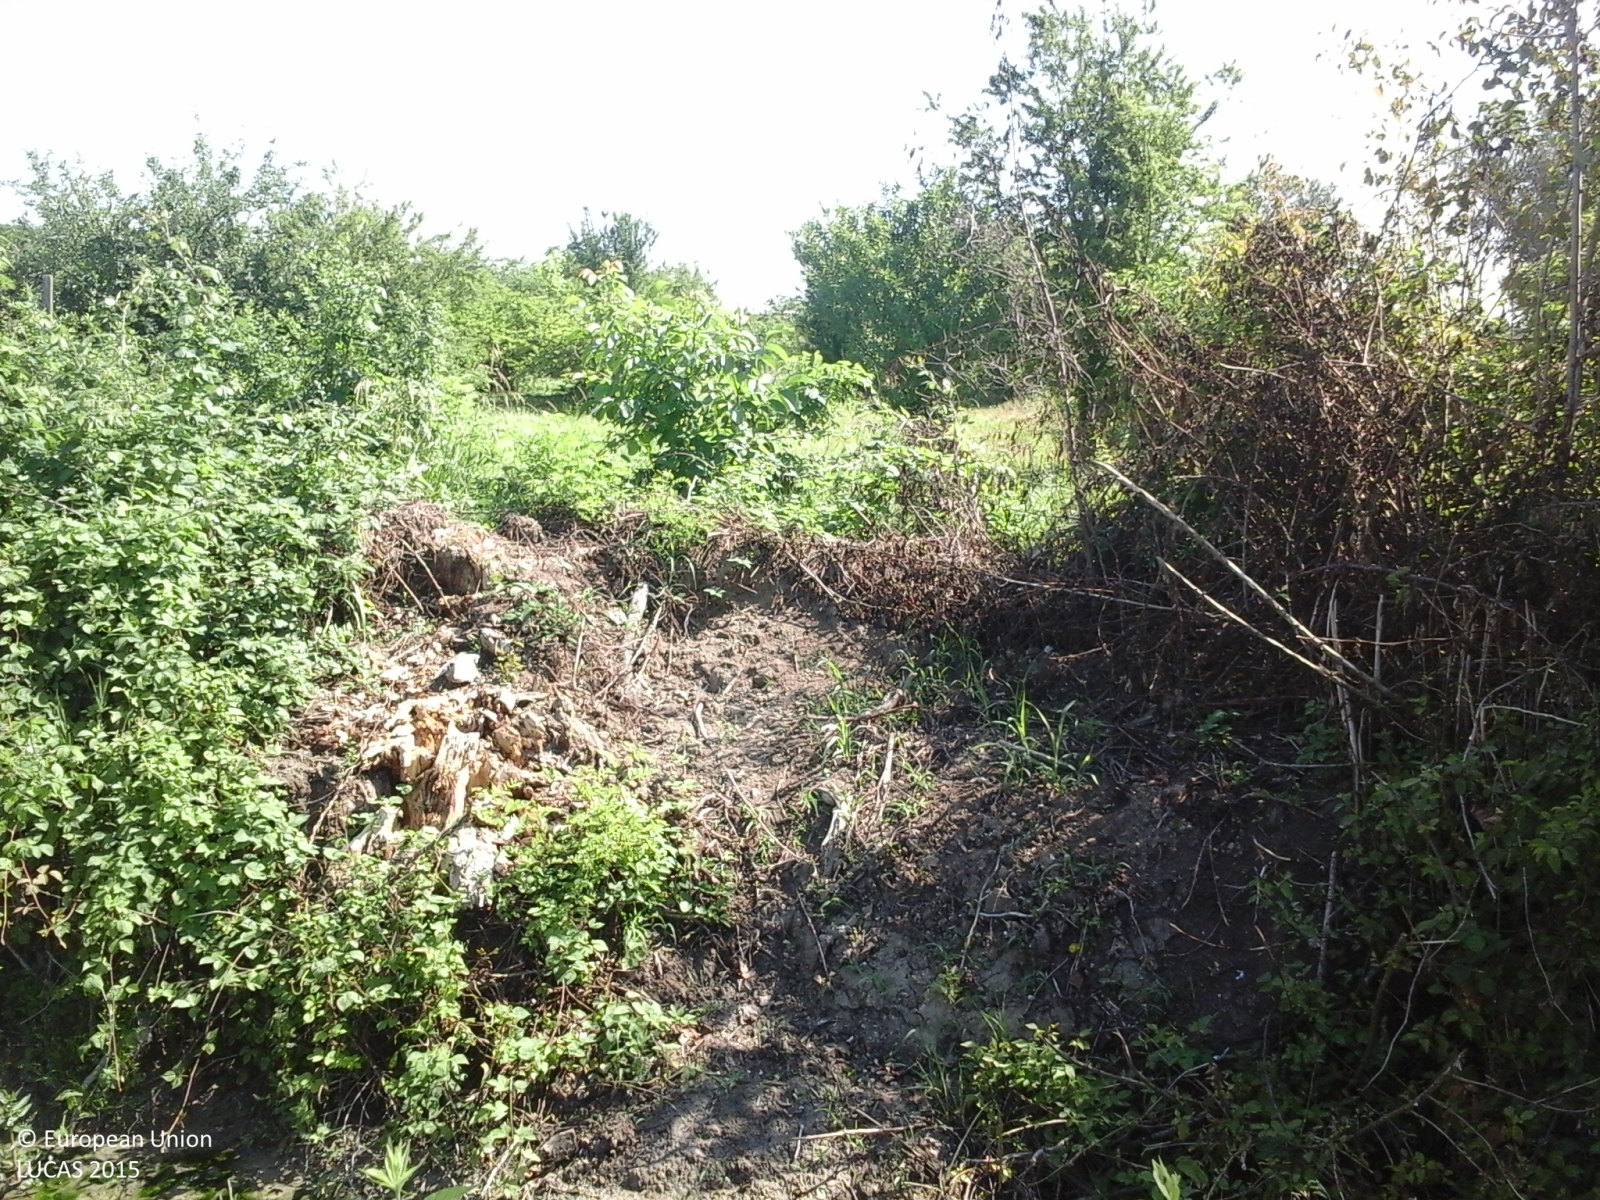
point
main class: Shrubland
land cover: Shrubland with sparse tree cover
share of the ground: > 75 %
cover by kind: shrubs 65 %, herbaceous plants 30 %, broadleaved forest trees 5 %
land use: Semi-natural and natural areas not in use
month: May
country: IT
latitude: 45.1398
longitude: 10.9266
